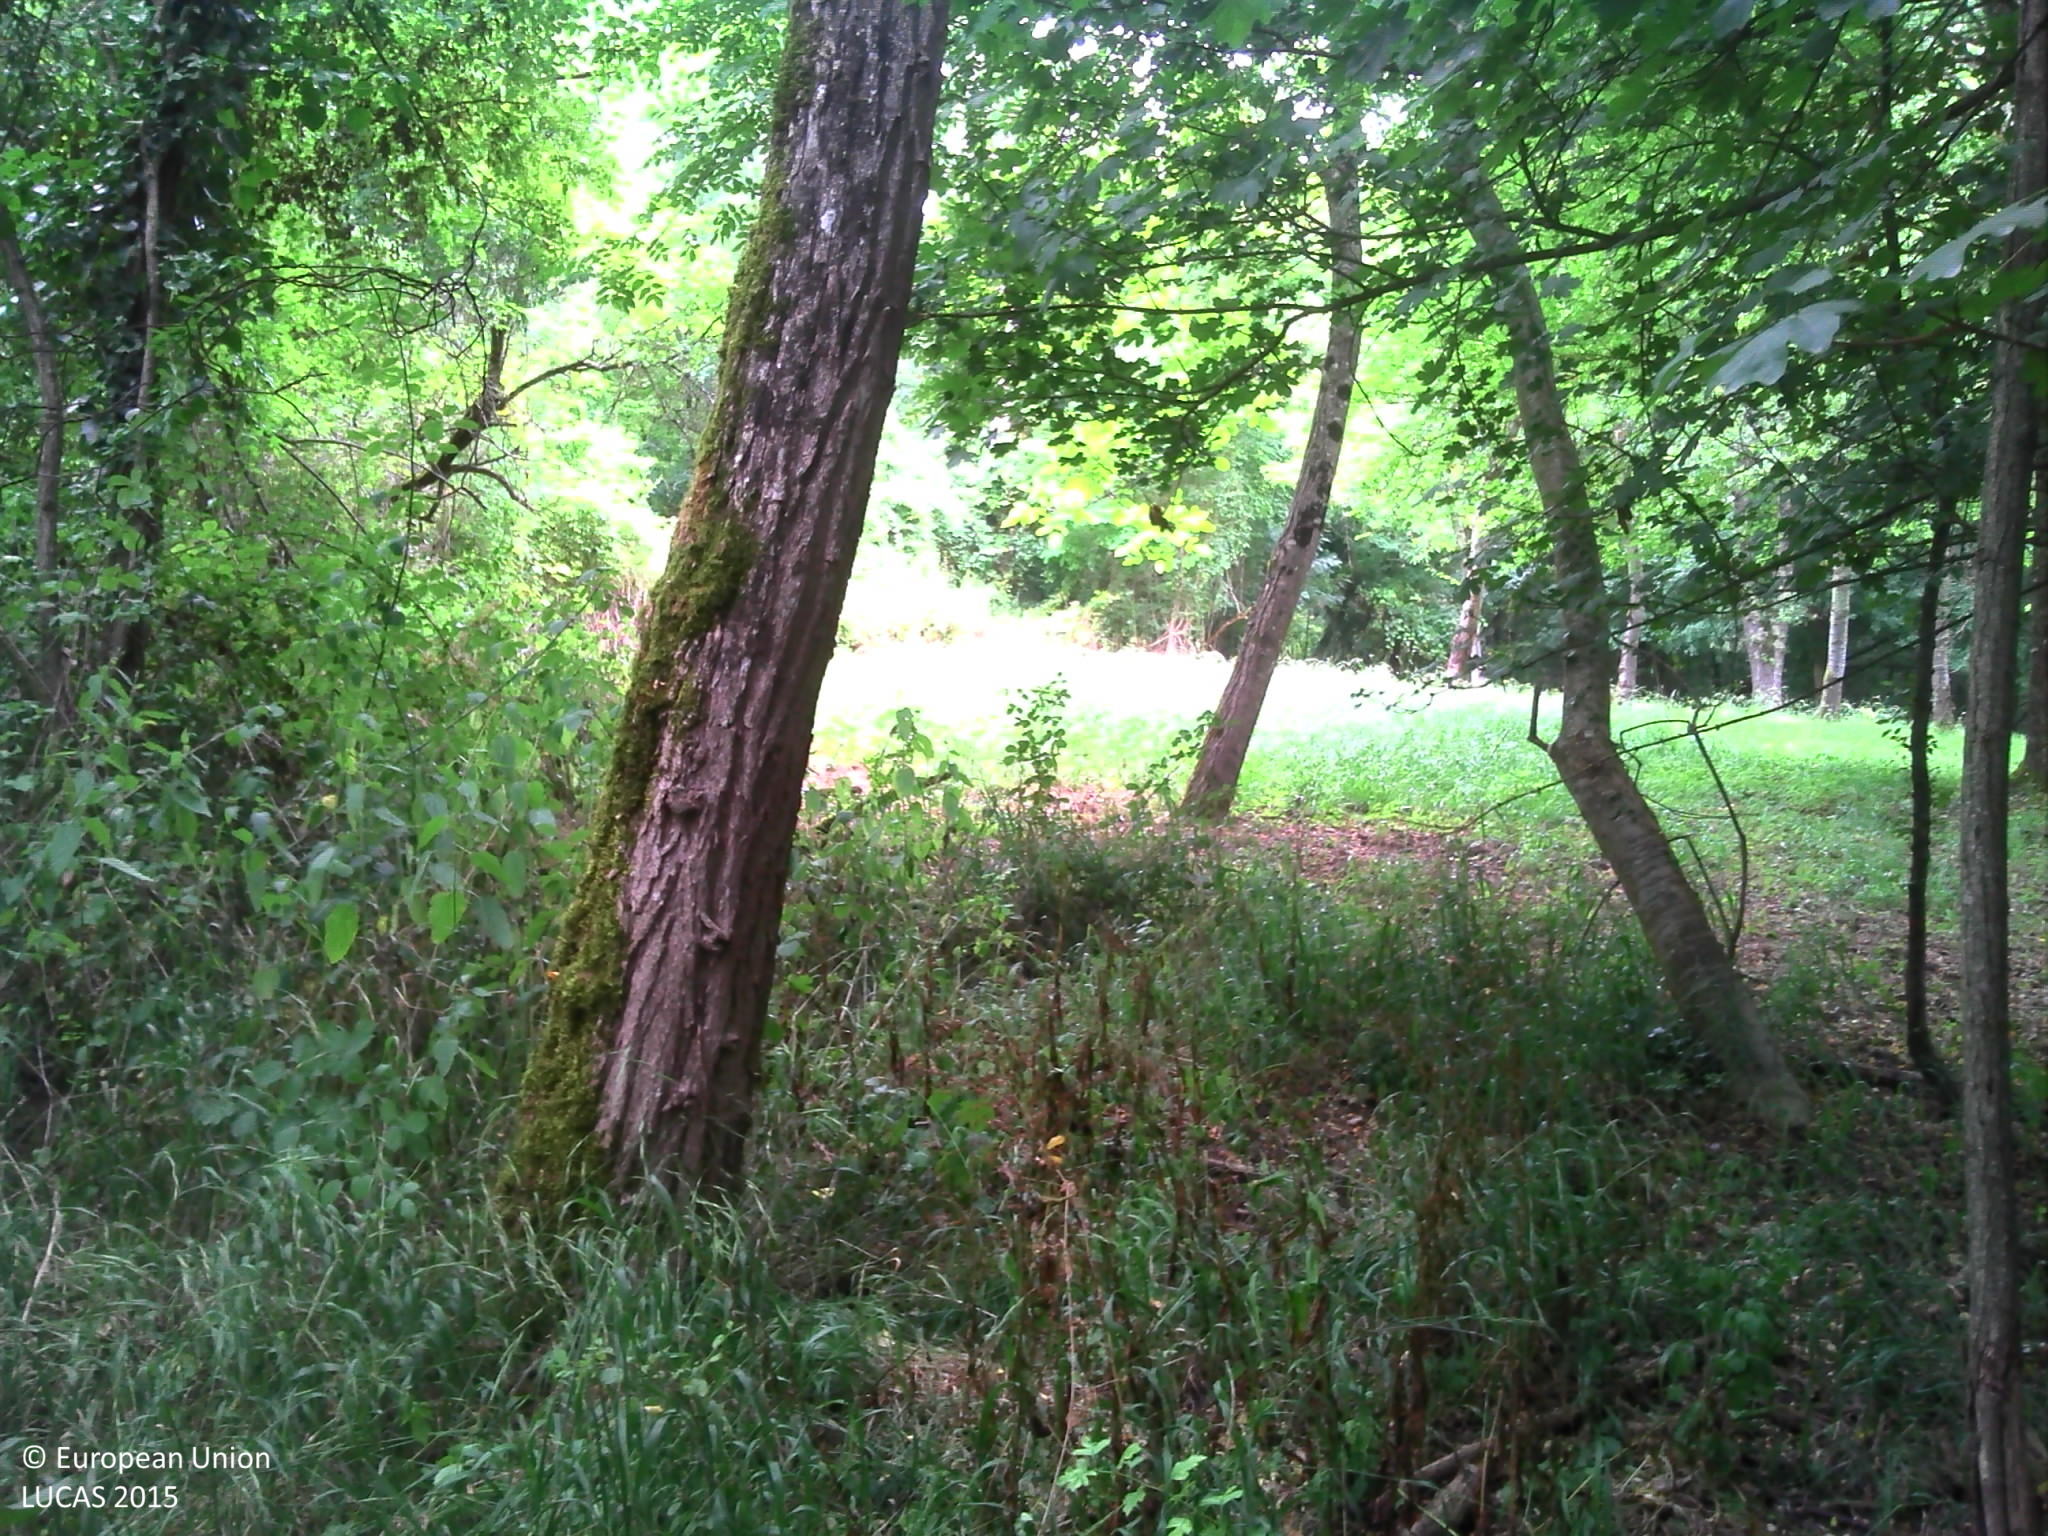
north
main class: Woodland
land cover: Broadleaved woodland
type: mesophytic deciduous forest
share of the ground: > 75 %
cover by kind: broadleaved forest trees 75 %, shrubs 10 %, herbaceous plants 10 %, lichens and mosses 5 %
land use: Forestry
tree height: > 5 m
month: July
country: FR
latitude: 47.3110
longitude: 0.3614
